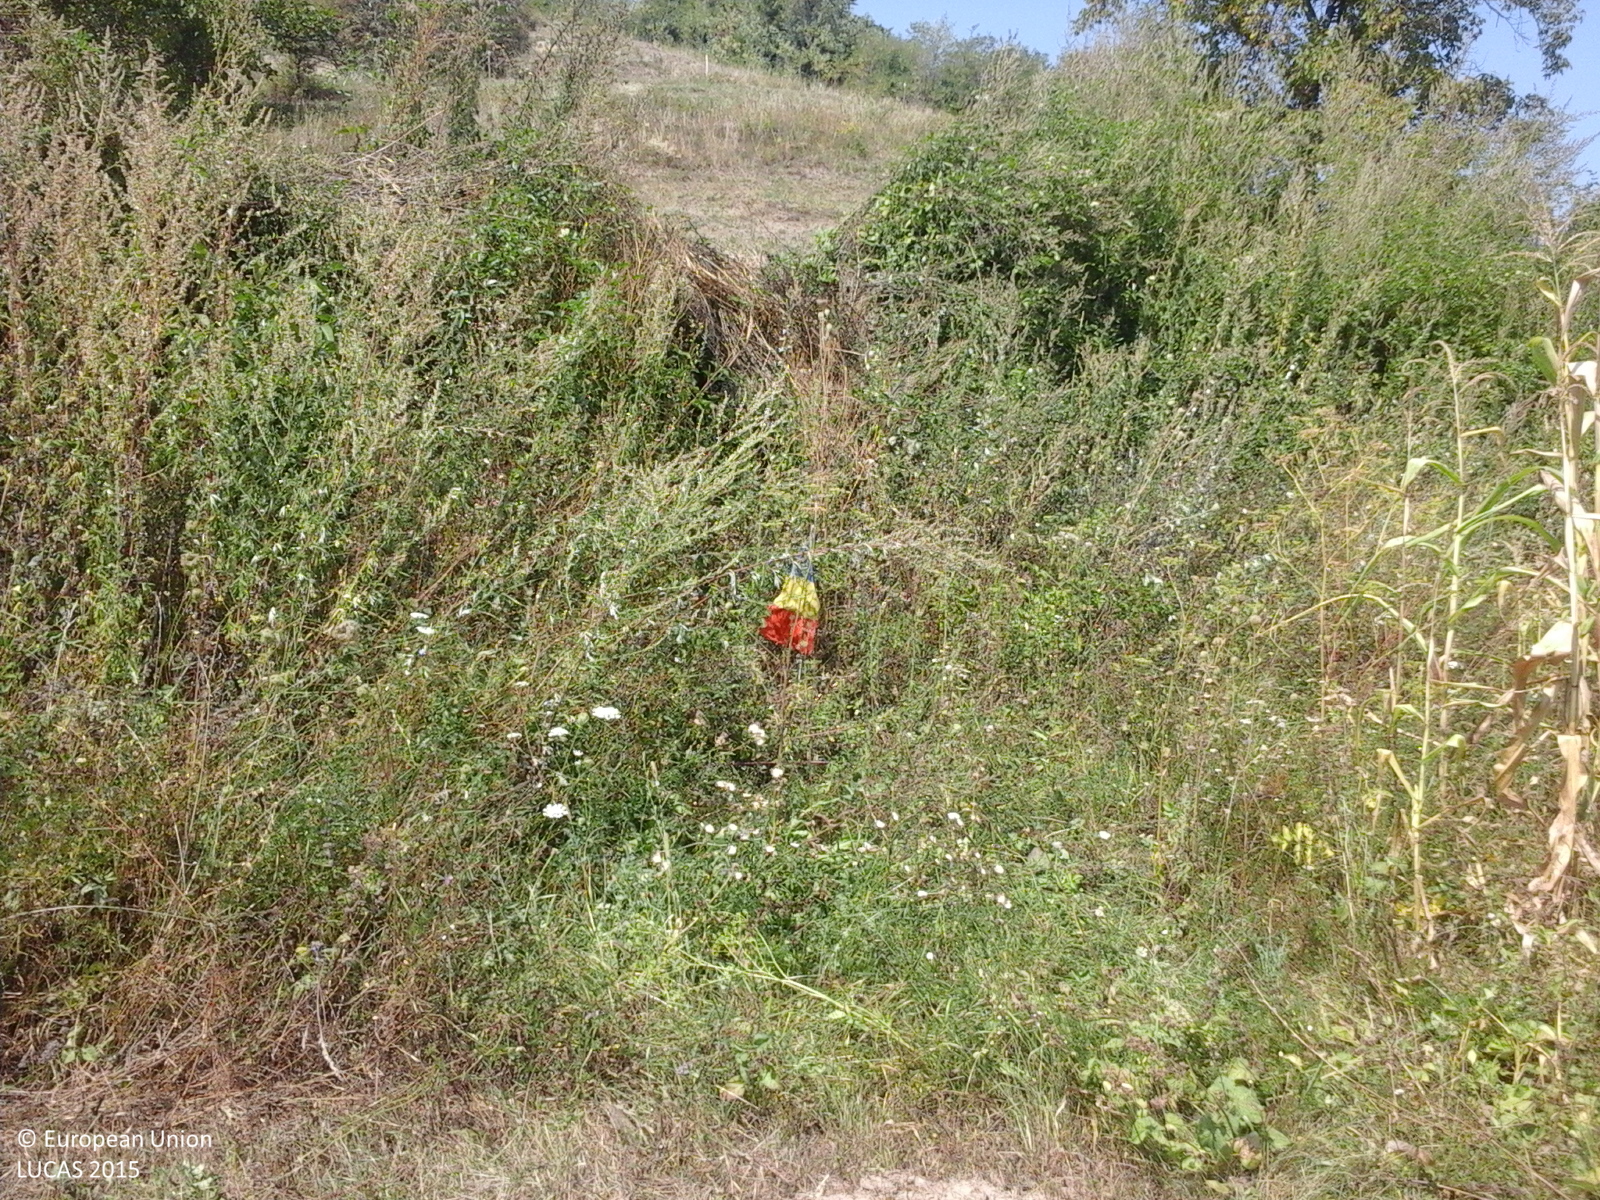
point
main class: Grassland
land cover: Spontaneously vegetated surfaces
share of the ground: > 75 %
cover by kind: herbaceous plants 100 %
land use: Fallow land
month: September
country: RO
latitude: 47.0731
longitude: 24.1078
